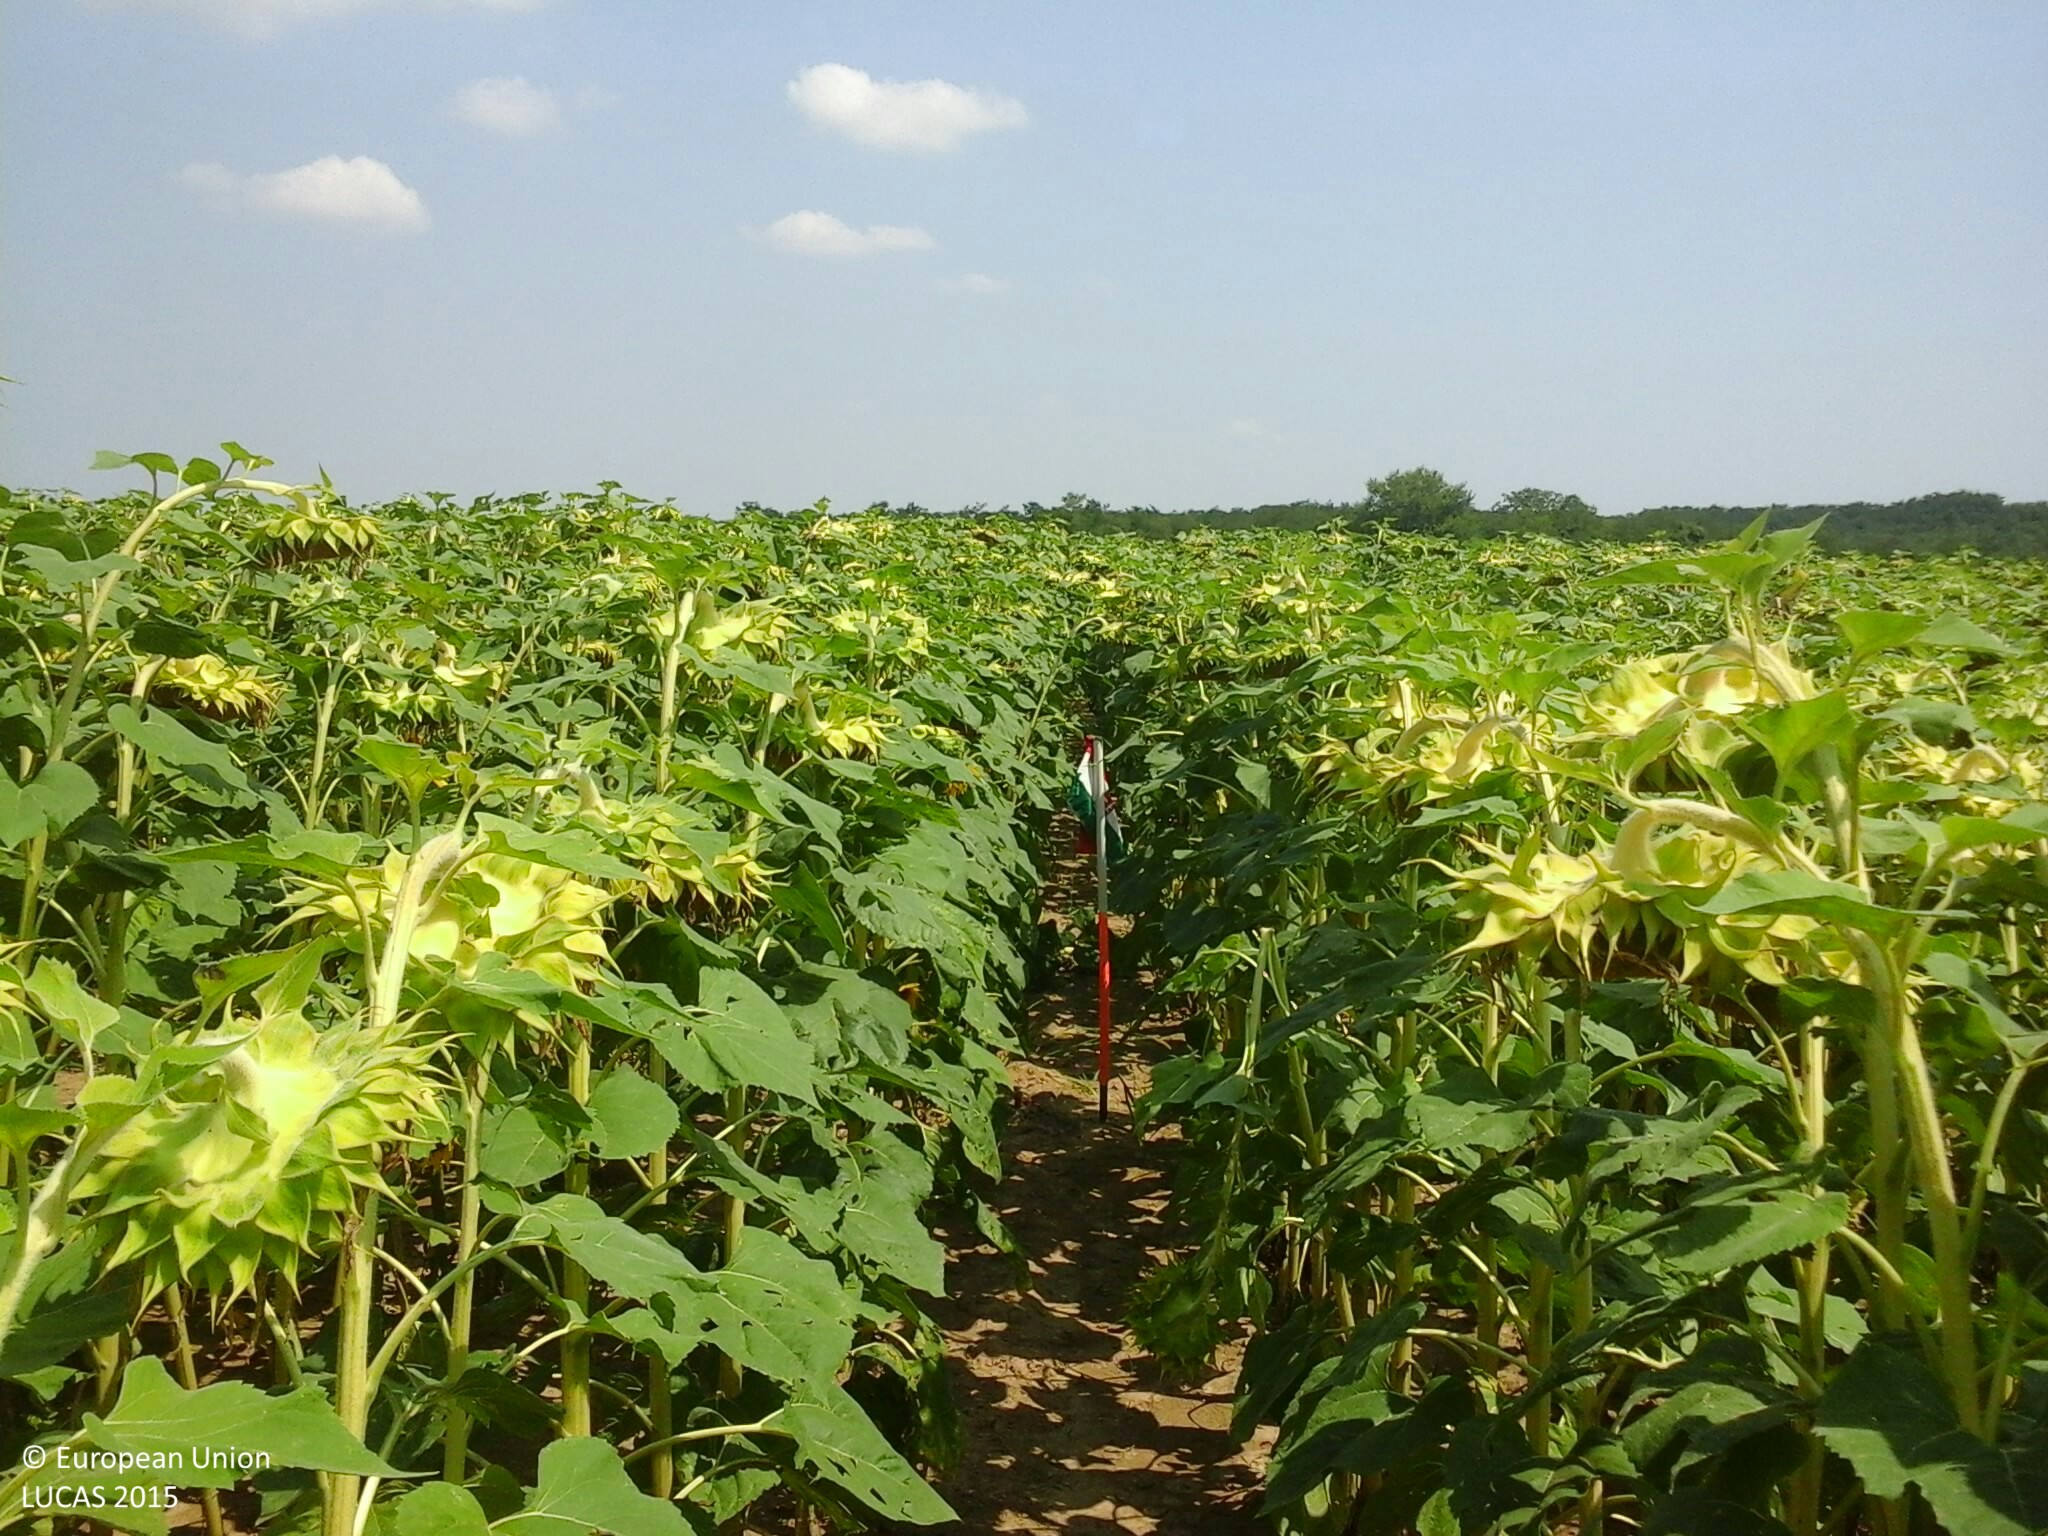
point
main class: Cropland
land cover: Sunflower
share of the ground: > 75 %
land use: Agriculture (excluding fallow land and kitchen gardens)
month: August
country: HU
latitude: 45.9238
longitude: 18.2464
